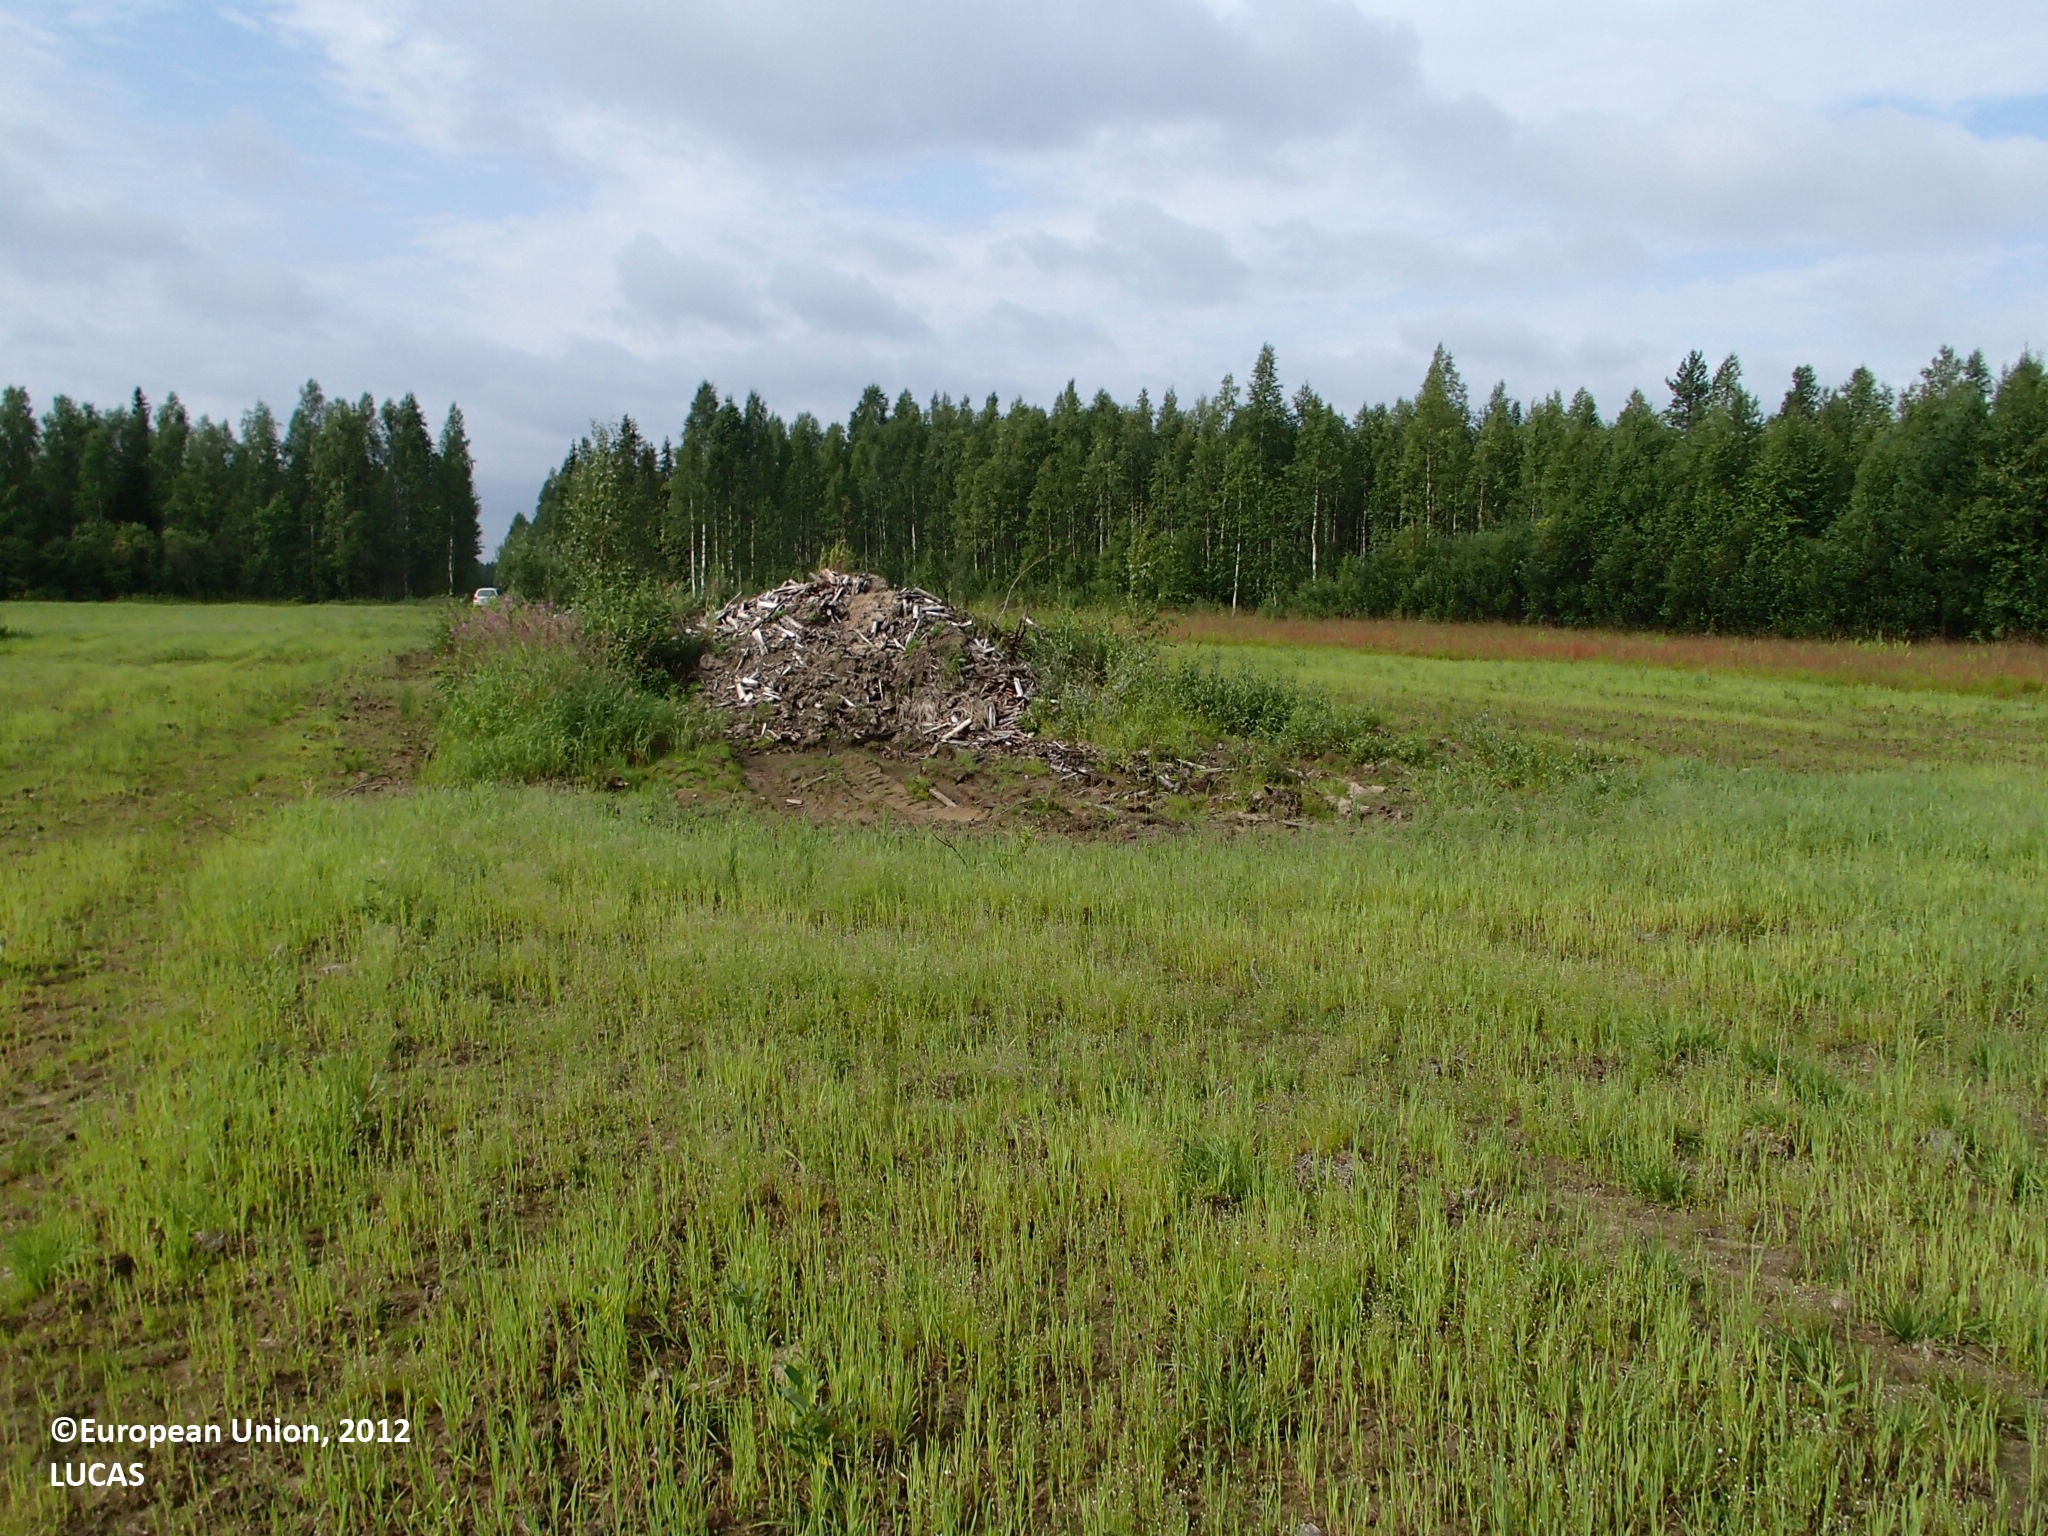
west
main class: Cropland
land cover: Temporary grasslands
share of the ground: 50 - 75 %
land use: Agriculture (excluding fallow land and kitchen gardens)
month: July
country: FI
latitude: 66.1829
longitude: 25.3104
